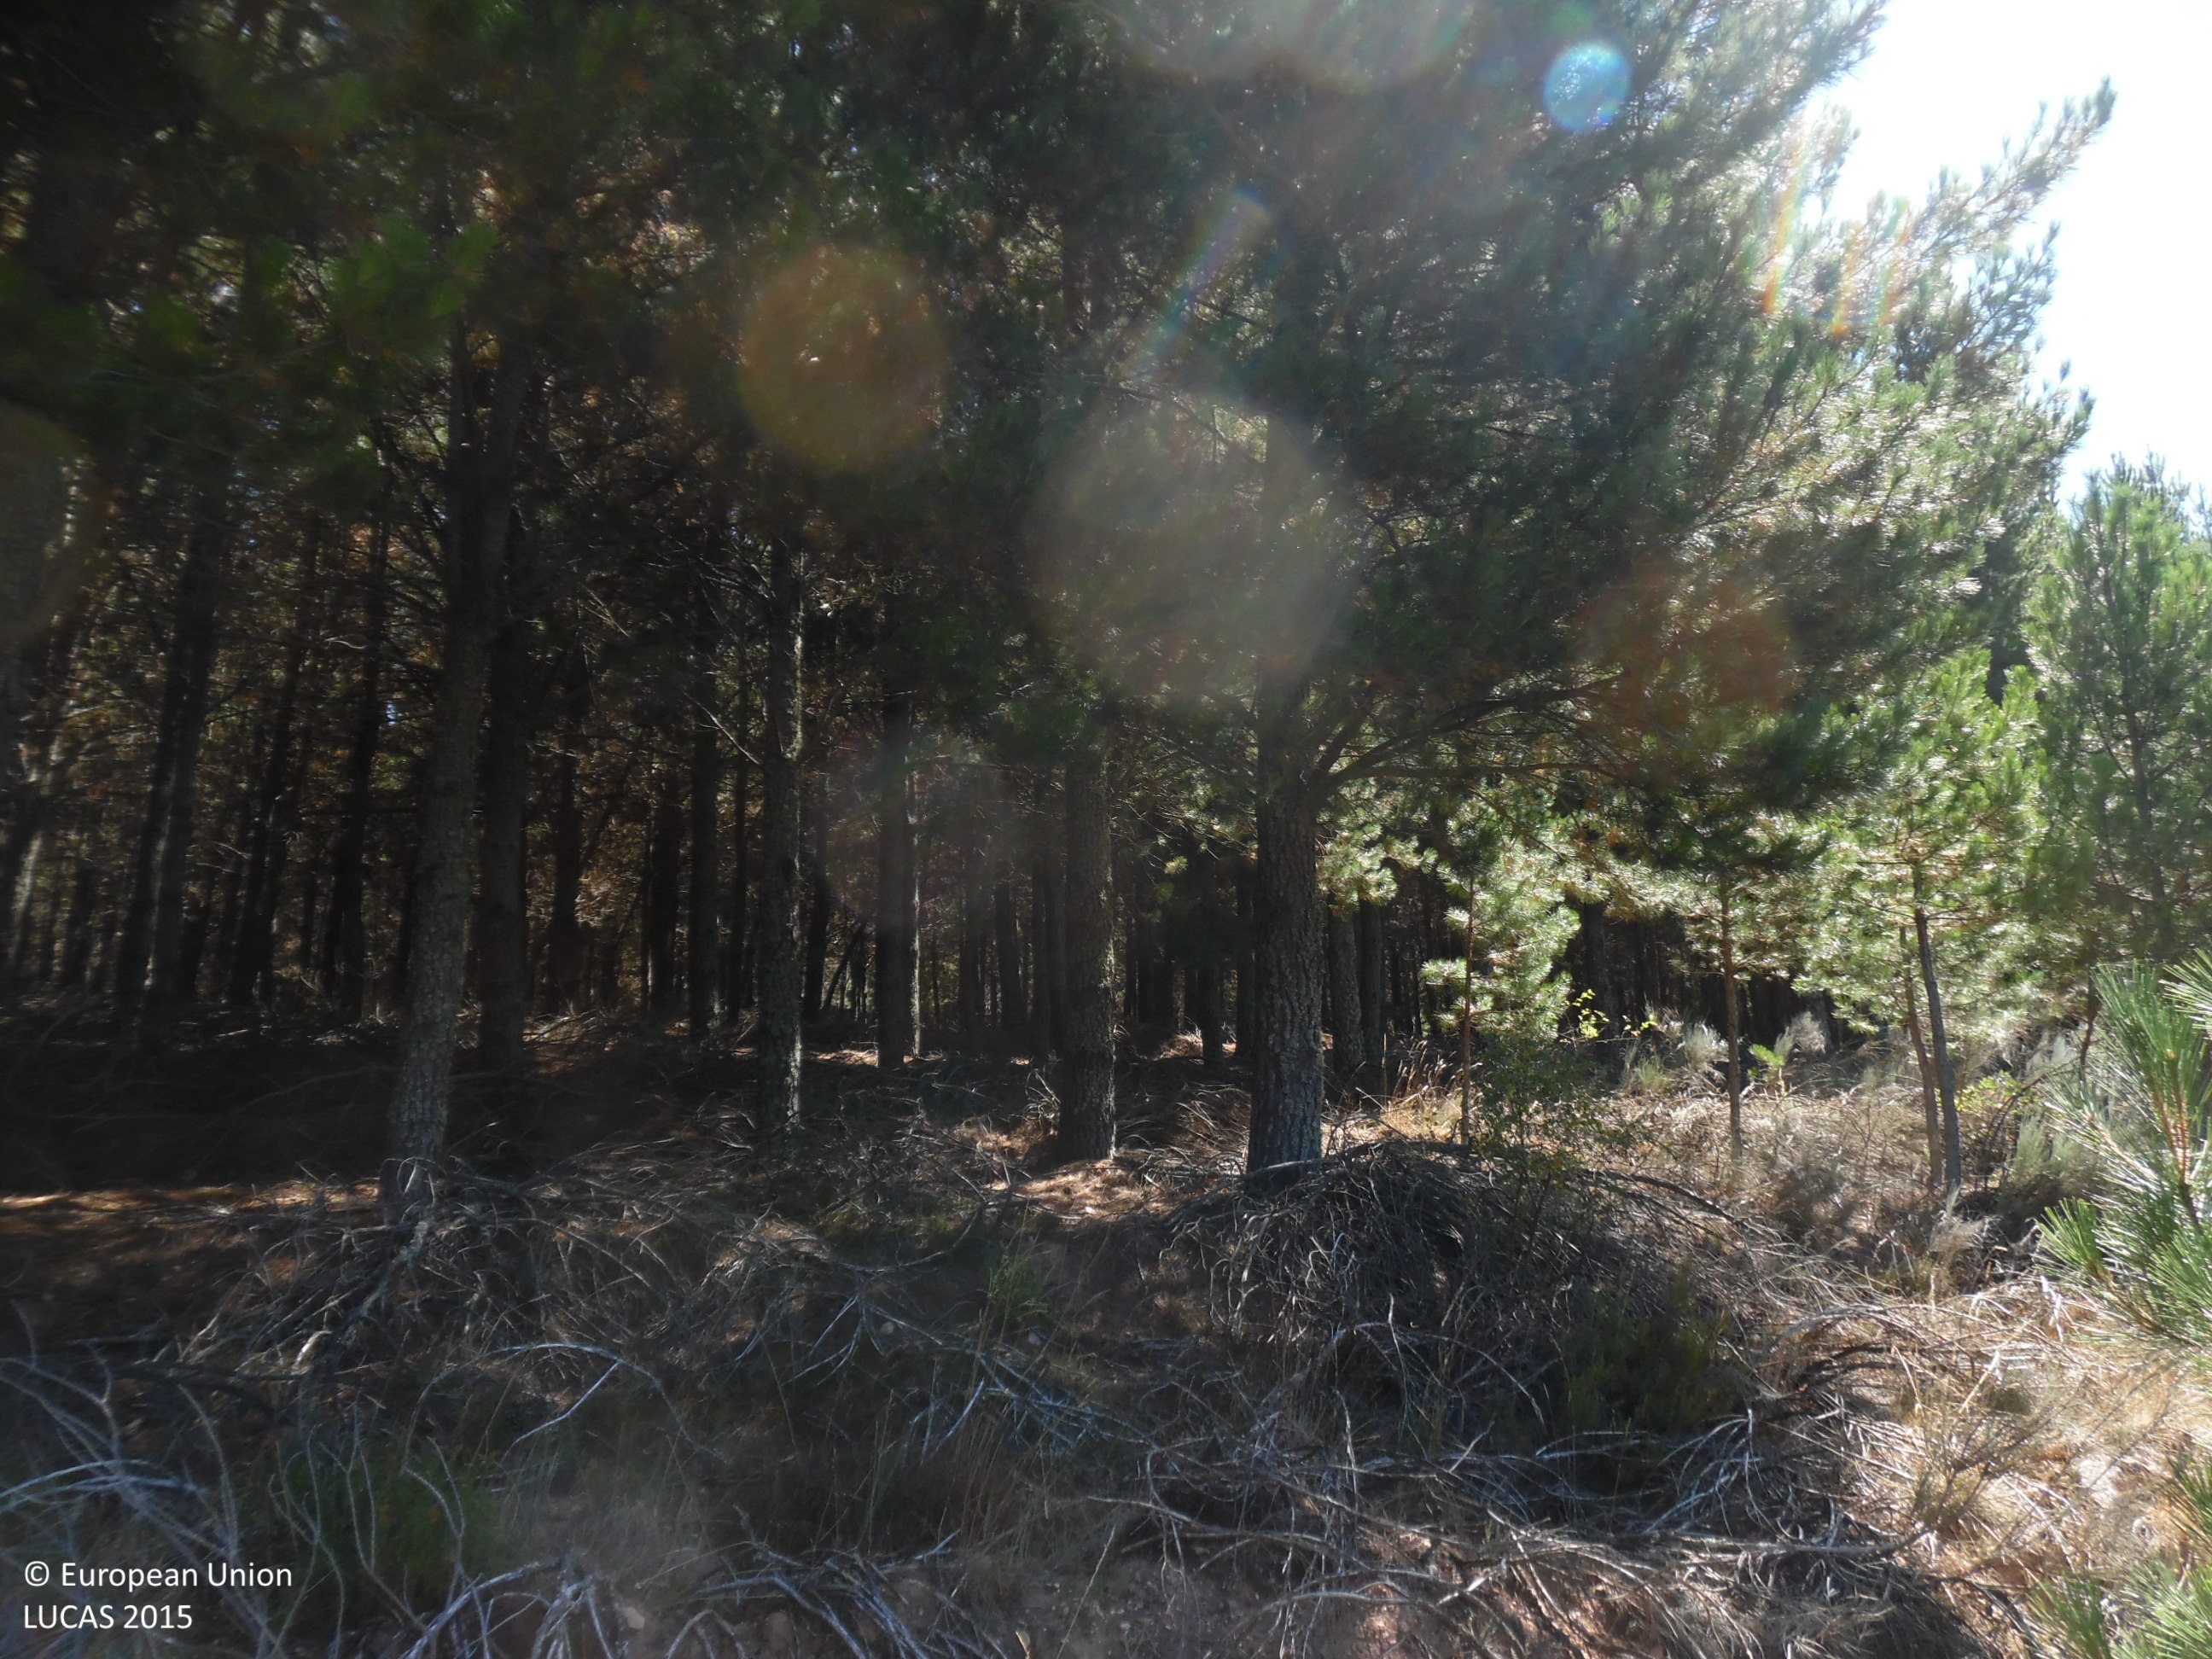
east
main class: Shrubland
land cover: Shrubland with sparse tree cover
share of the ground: > 75 %
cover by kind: shrubs 95 %, coniferous forest trees 5 %
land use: Abandoned areas
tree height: < 5 m
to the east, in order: Shrubland with sparse tree cover; Pine dominated coniferous woodland
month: August
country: ES
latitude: 42.6802
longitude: -6.4337
